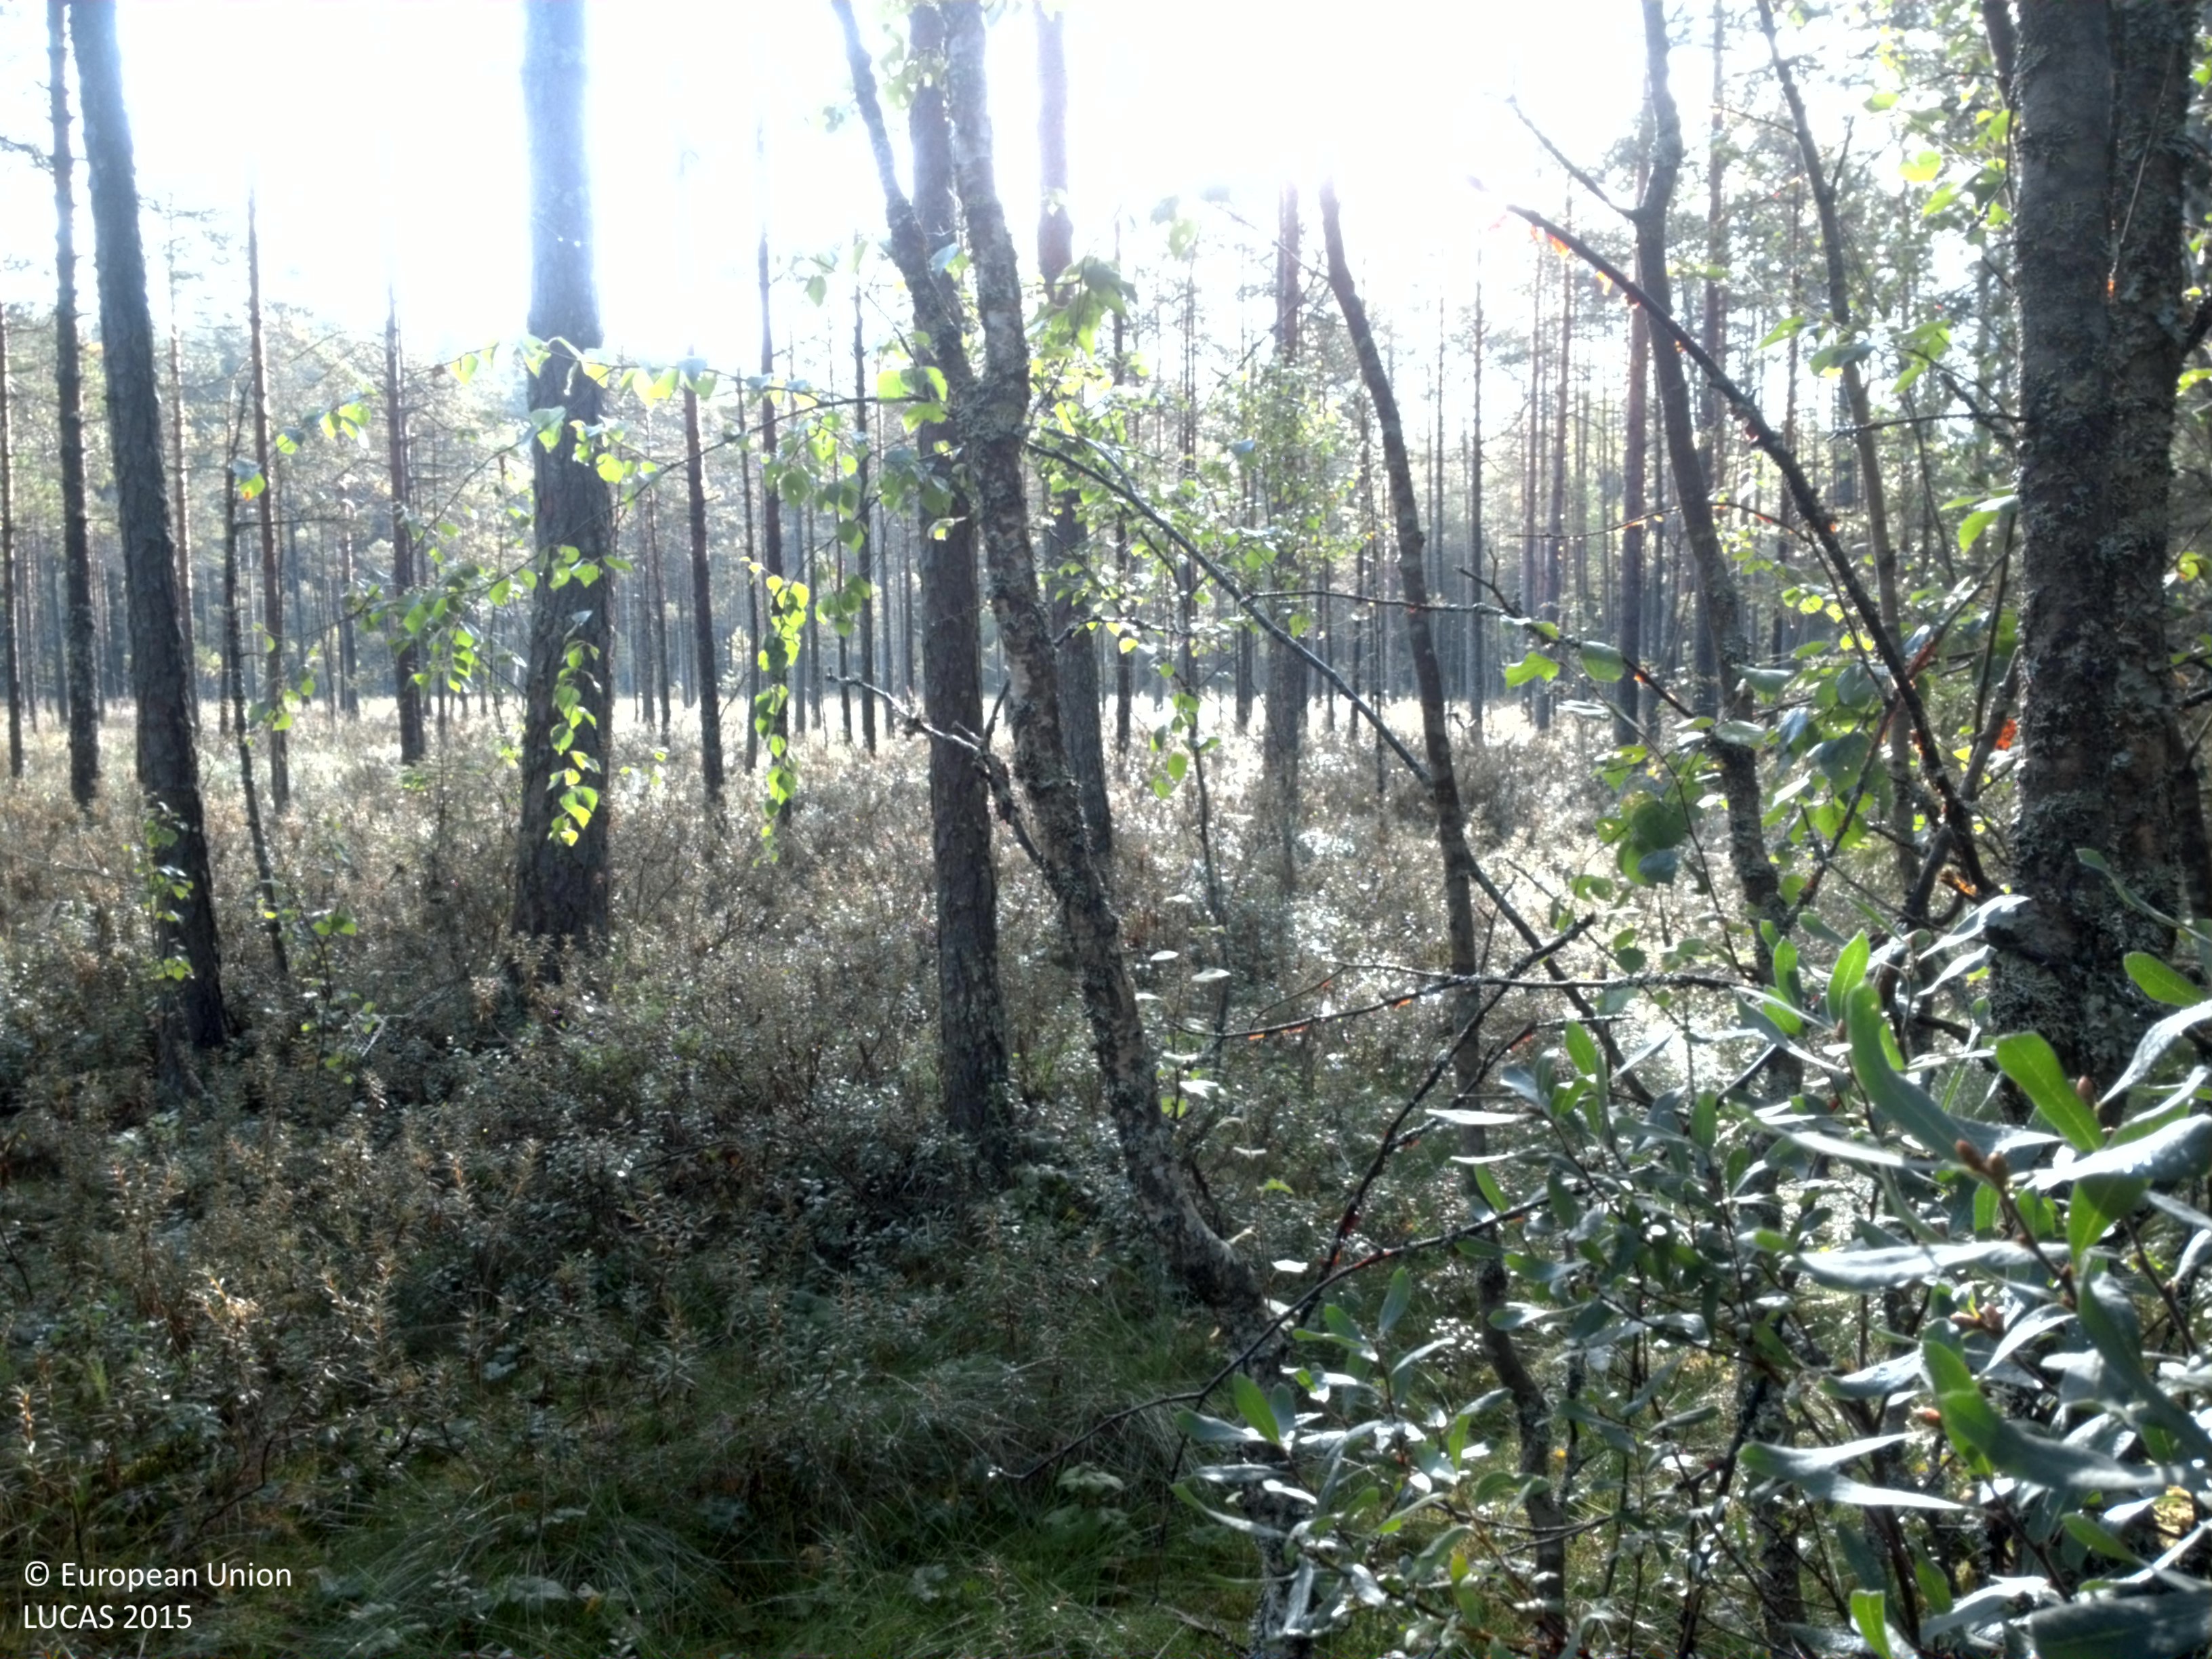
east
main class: Woodland
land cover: Pine dominated mixed woodland
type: boreal forest
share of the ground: 50 - 75 %
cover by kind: coniferous forest trees 45 %, broadleaved forest trees 20 %, shrubs 20 %, lichens and mosses 15 %
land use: Forestry
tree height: > 5 m
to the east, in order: Pine dominated mixed woodland; Pine dominated coniferous woodland; Inland marshes; Pine dominated coniferous woodland; Spruce dominated coniferous woodland
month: August
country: SE
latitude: 59.8165
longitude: 15.6071
